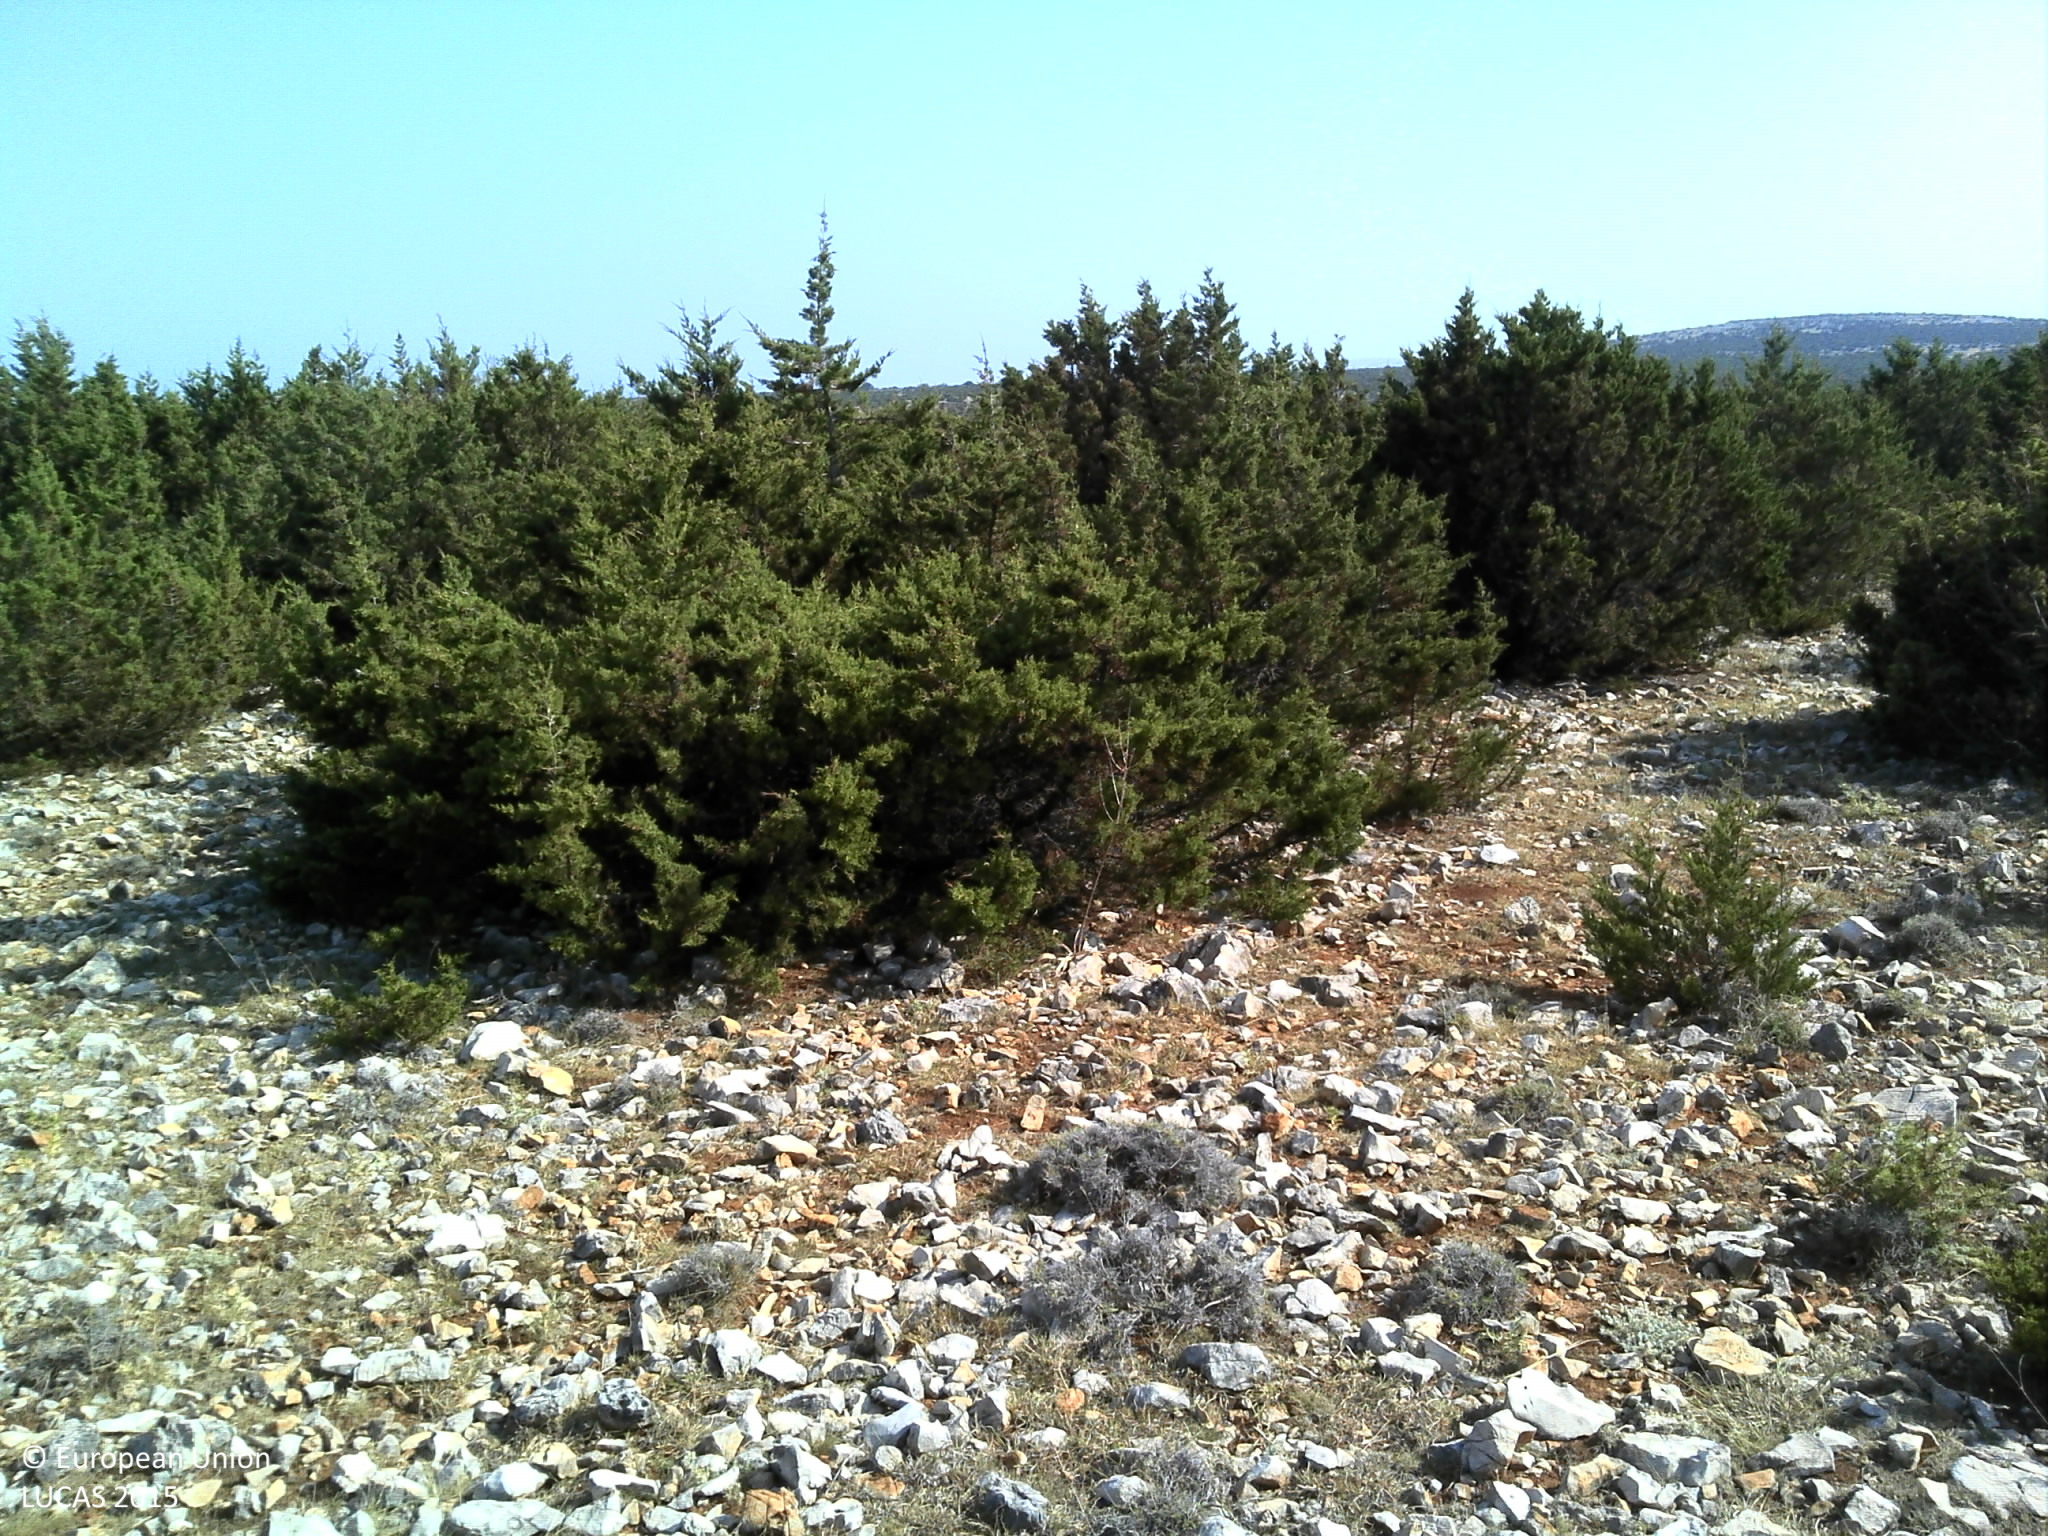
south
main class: Shrubland
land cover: Shrubland with sparse tree cover
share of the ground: 25 - 50 %
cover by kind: shrubs 40 %, consolidated bare surface 20 %, unconsolidated bare surface 20 %, herbaceous plants 15 %, coniferous forest trees 5 %
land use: Semi-natural and natural areas not in use
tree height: < 5 m
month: July
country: HR
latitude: 44.4081
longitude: 15.0534
